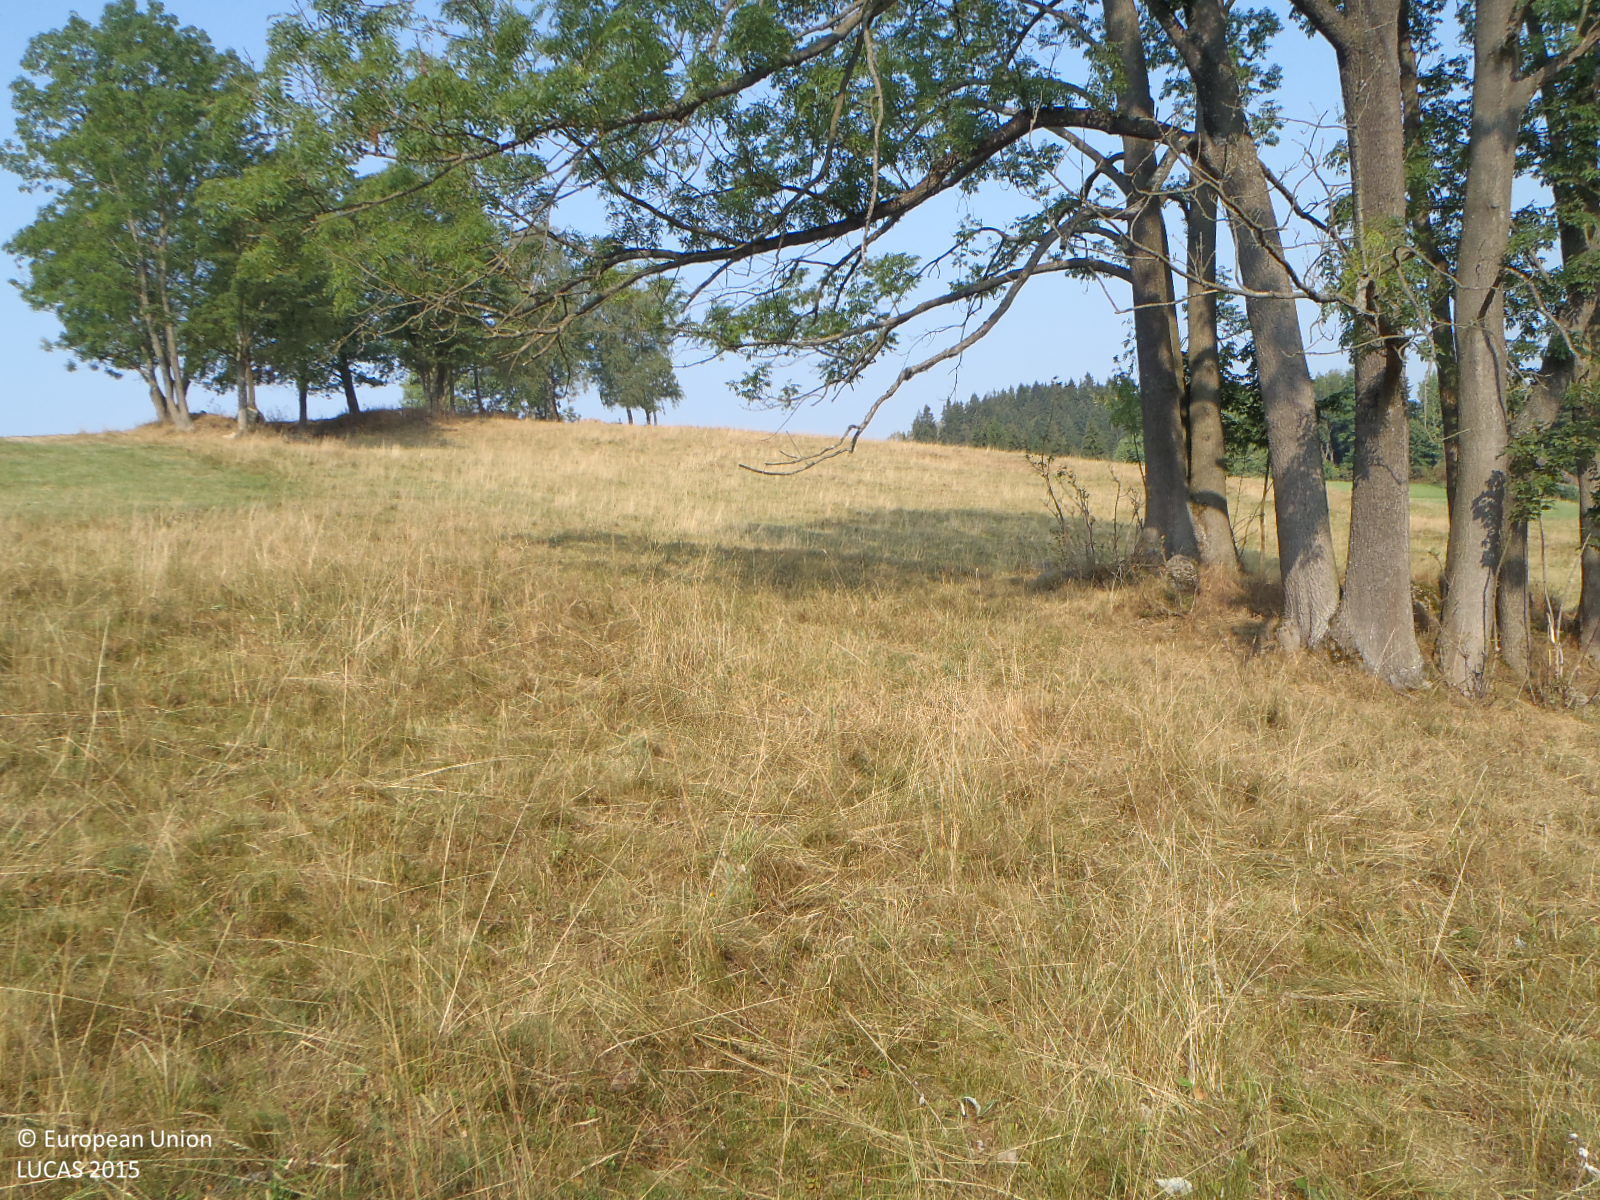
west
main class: Grassland
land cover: Grassland without tree/shrub cover
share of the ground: > 75 %
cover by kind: herbaceous plants 100 %
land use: Agriculture (excluding fallow land and kitchen gardens)
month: August
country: CZ
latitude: 50.7488
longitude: 15.2334
